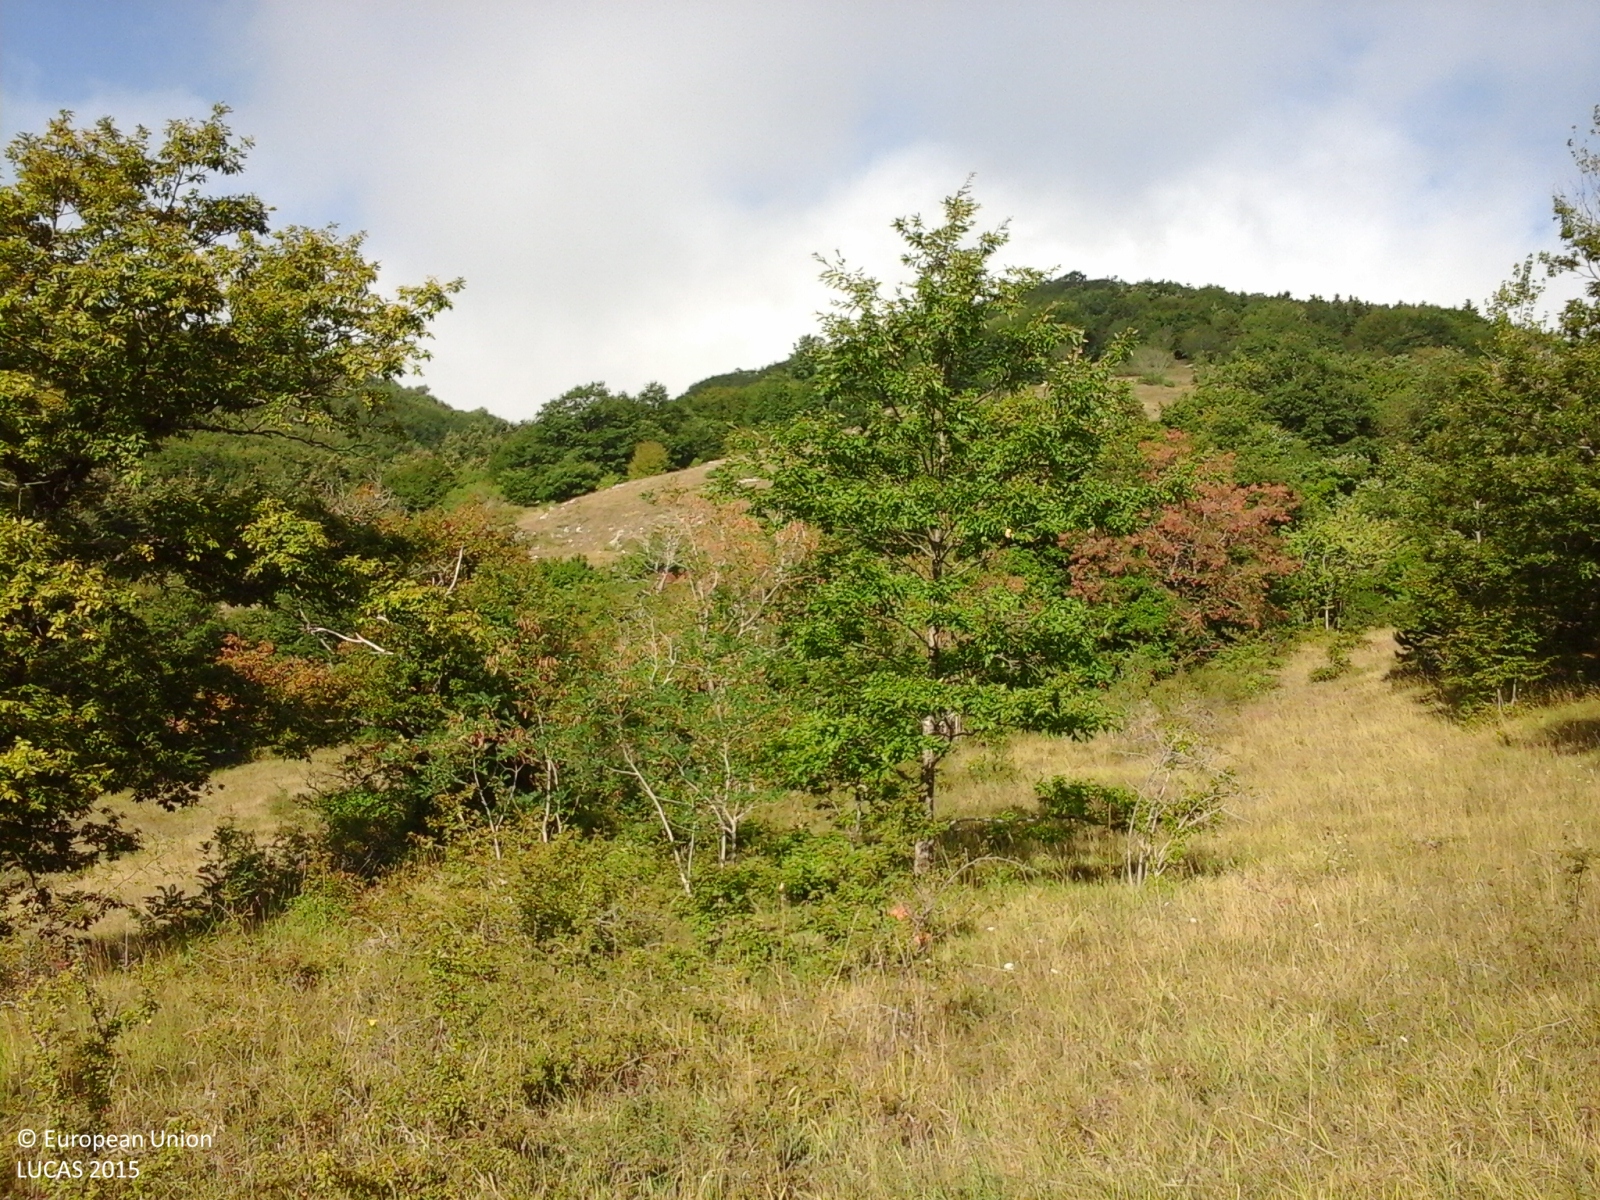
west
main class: Grassland
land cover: Grassland with sparse tree/shrub cover
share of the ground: > 75 %
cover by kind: herbaceous plants 90 %, broadleaved forest trees 5 %, shrubs 5 %
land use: Agriculture (excluding fallow land and kitchen gardens)
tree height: > 5 m
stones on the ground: < 10 %
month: August
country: IT
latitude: 41.7305
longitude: 14.3011
